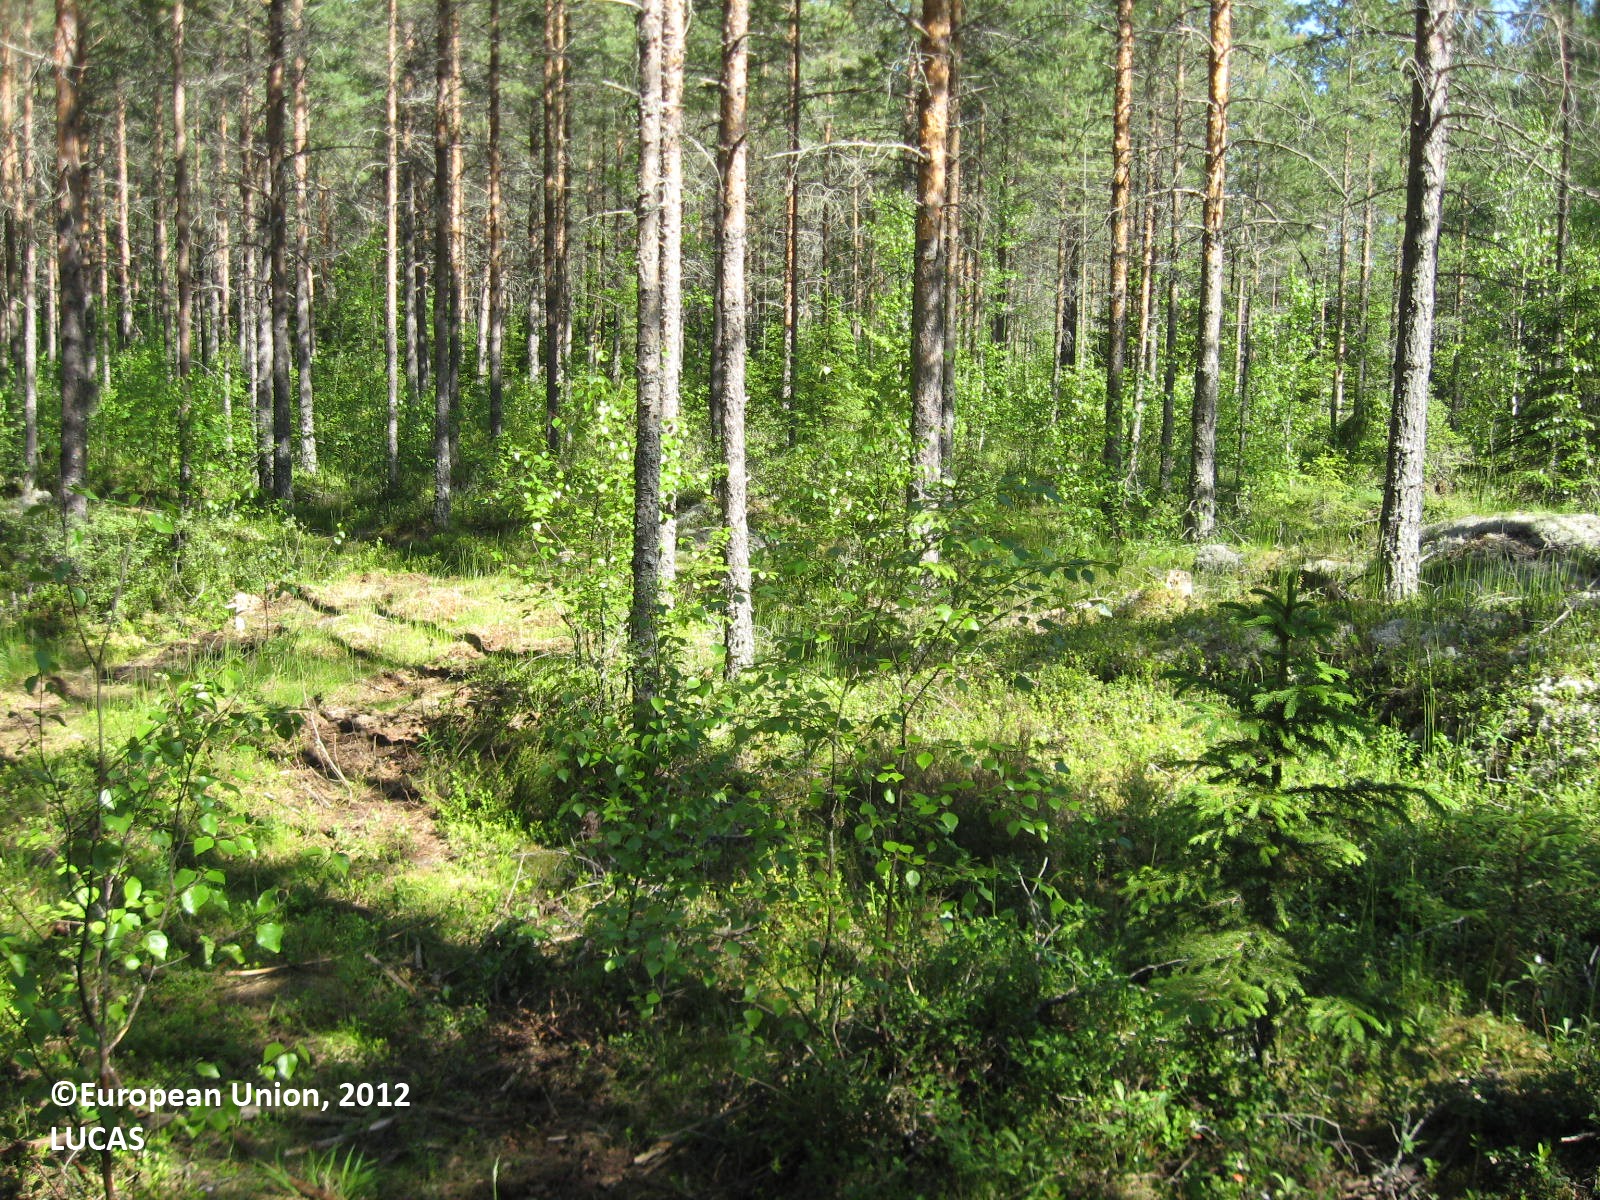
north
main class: Woodland
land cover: Pine dominated coniferous woodland
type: boreal forest
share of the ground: > 75 %
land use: Forestry
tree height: > 5 m
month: June
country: FI
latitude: 62.8317
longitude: 21.6839
